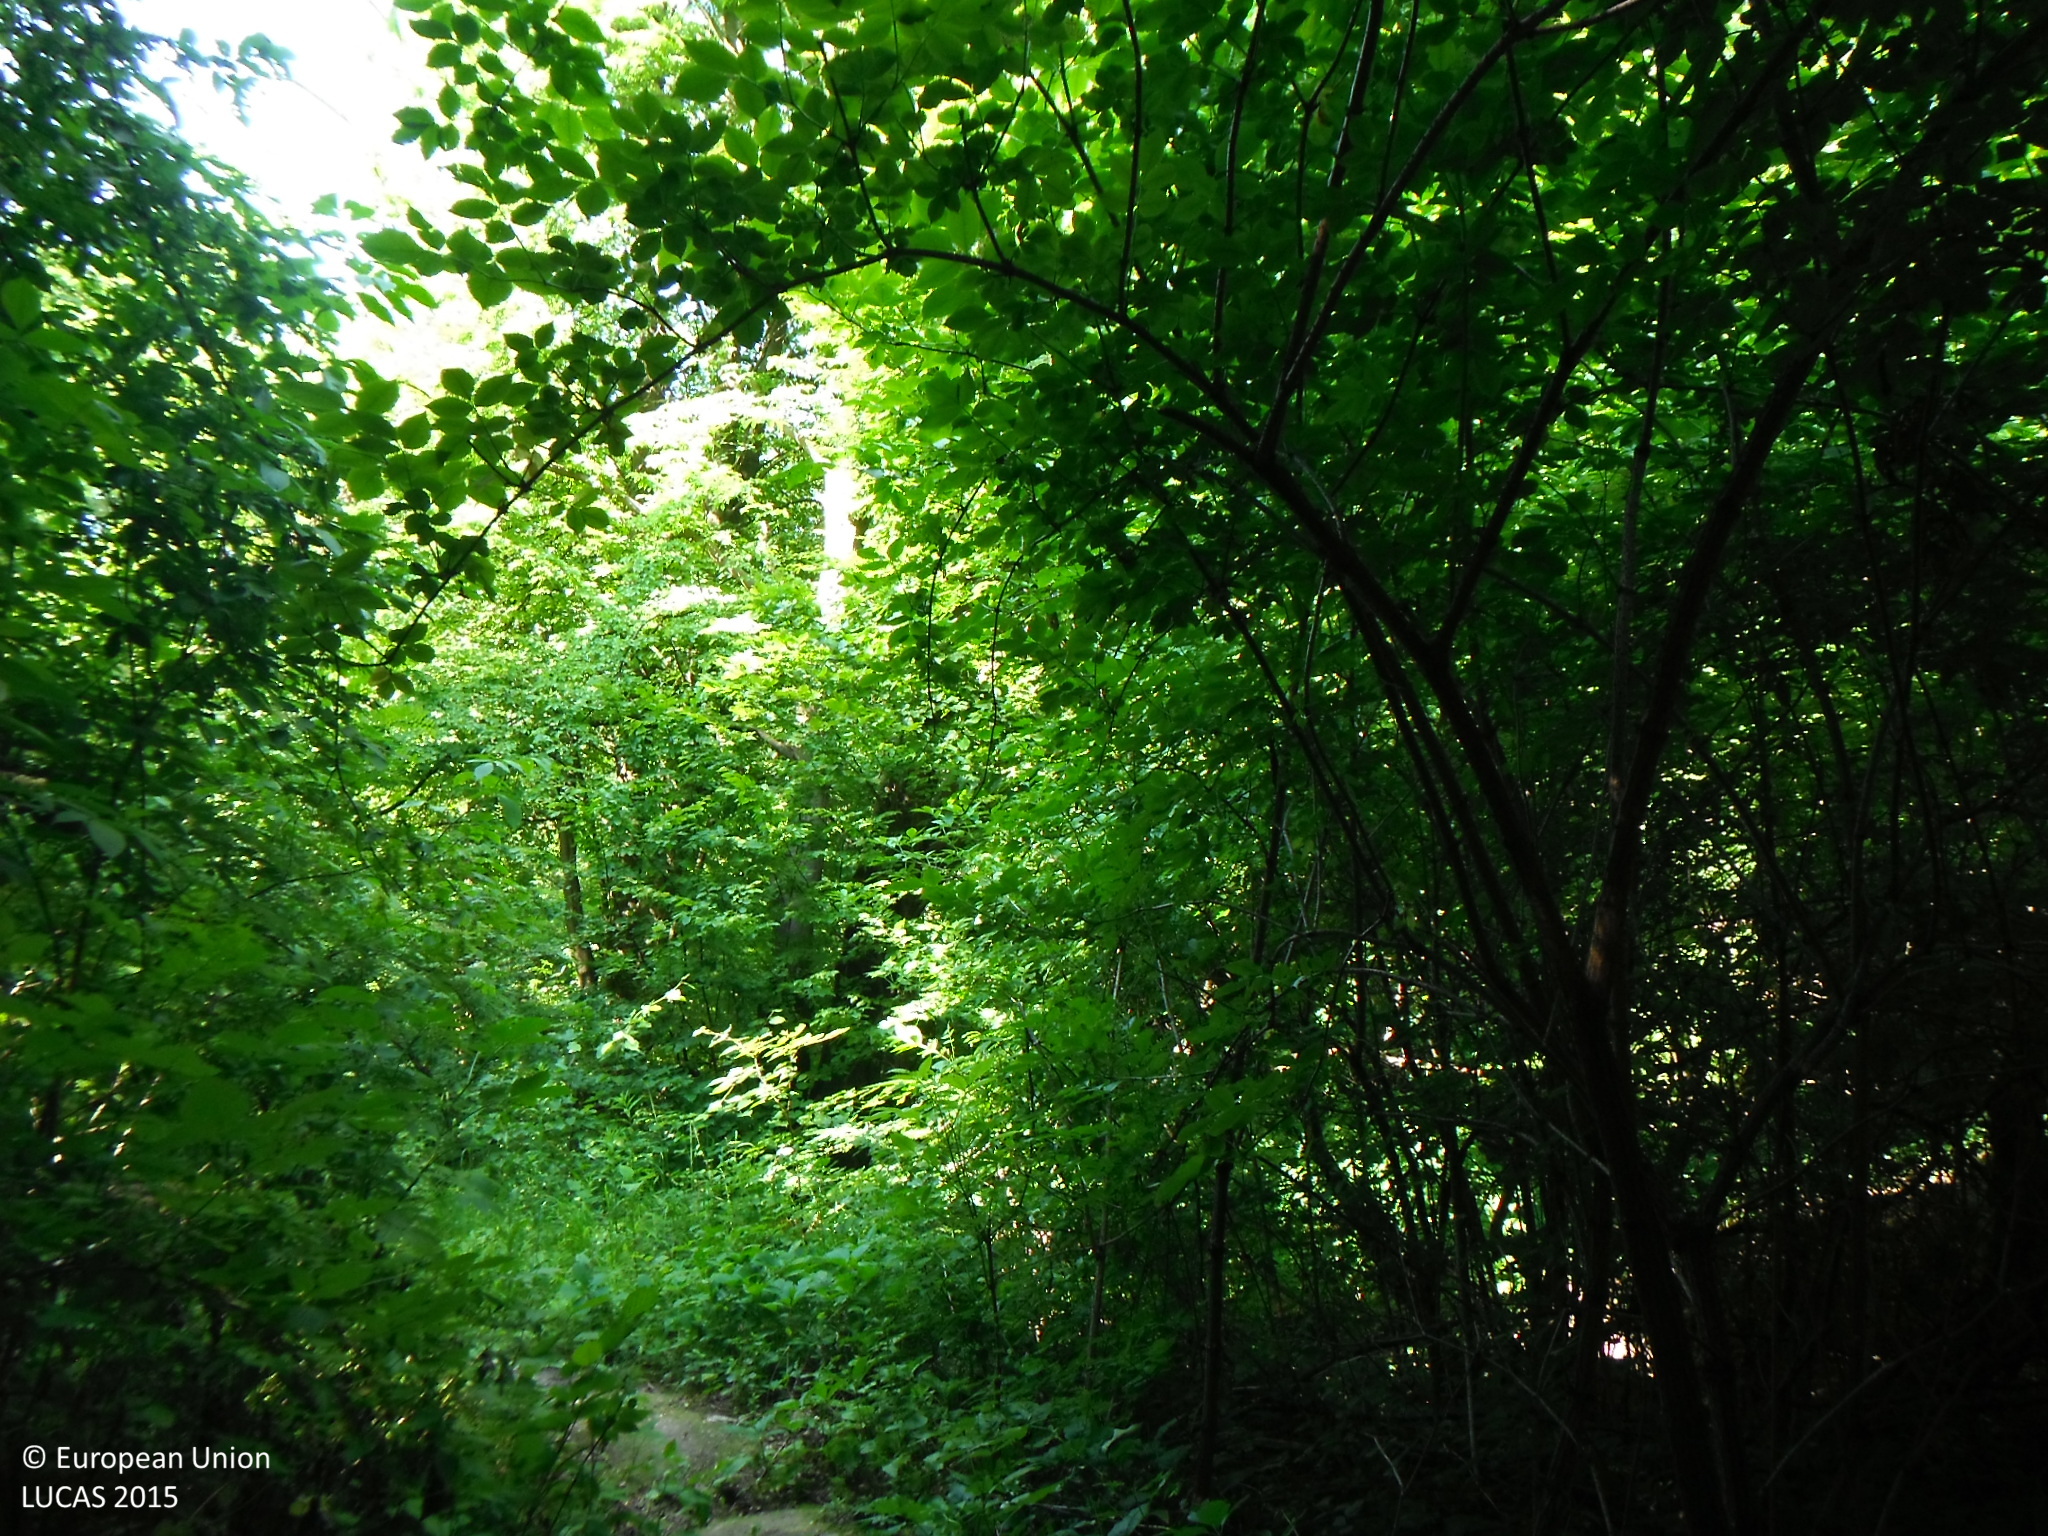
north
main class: Woodland
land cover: Broadleaved woodland
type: mesophytic deciduous forest
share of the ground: > 75 %
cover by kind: broadleaved forest trees 80 %, shrubs 20 %
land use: Semi-natural and natural areas not in use
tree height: > 5 m
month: June
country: SK
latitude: 48.7139
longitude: 21.2846
